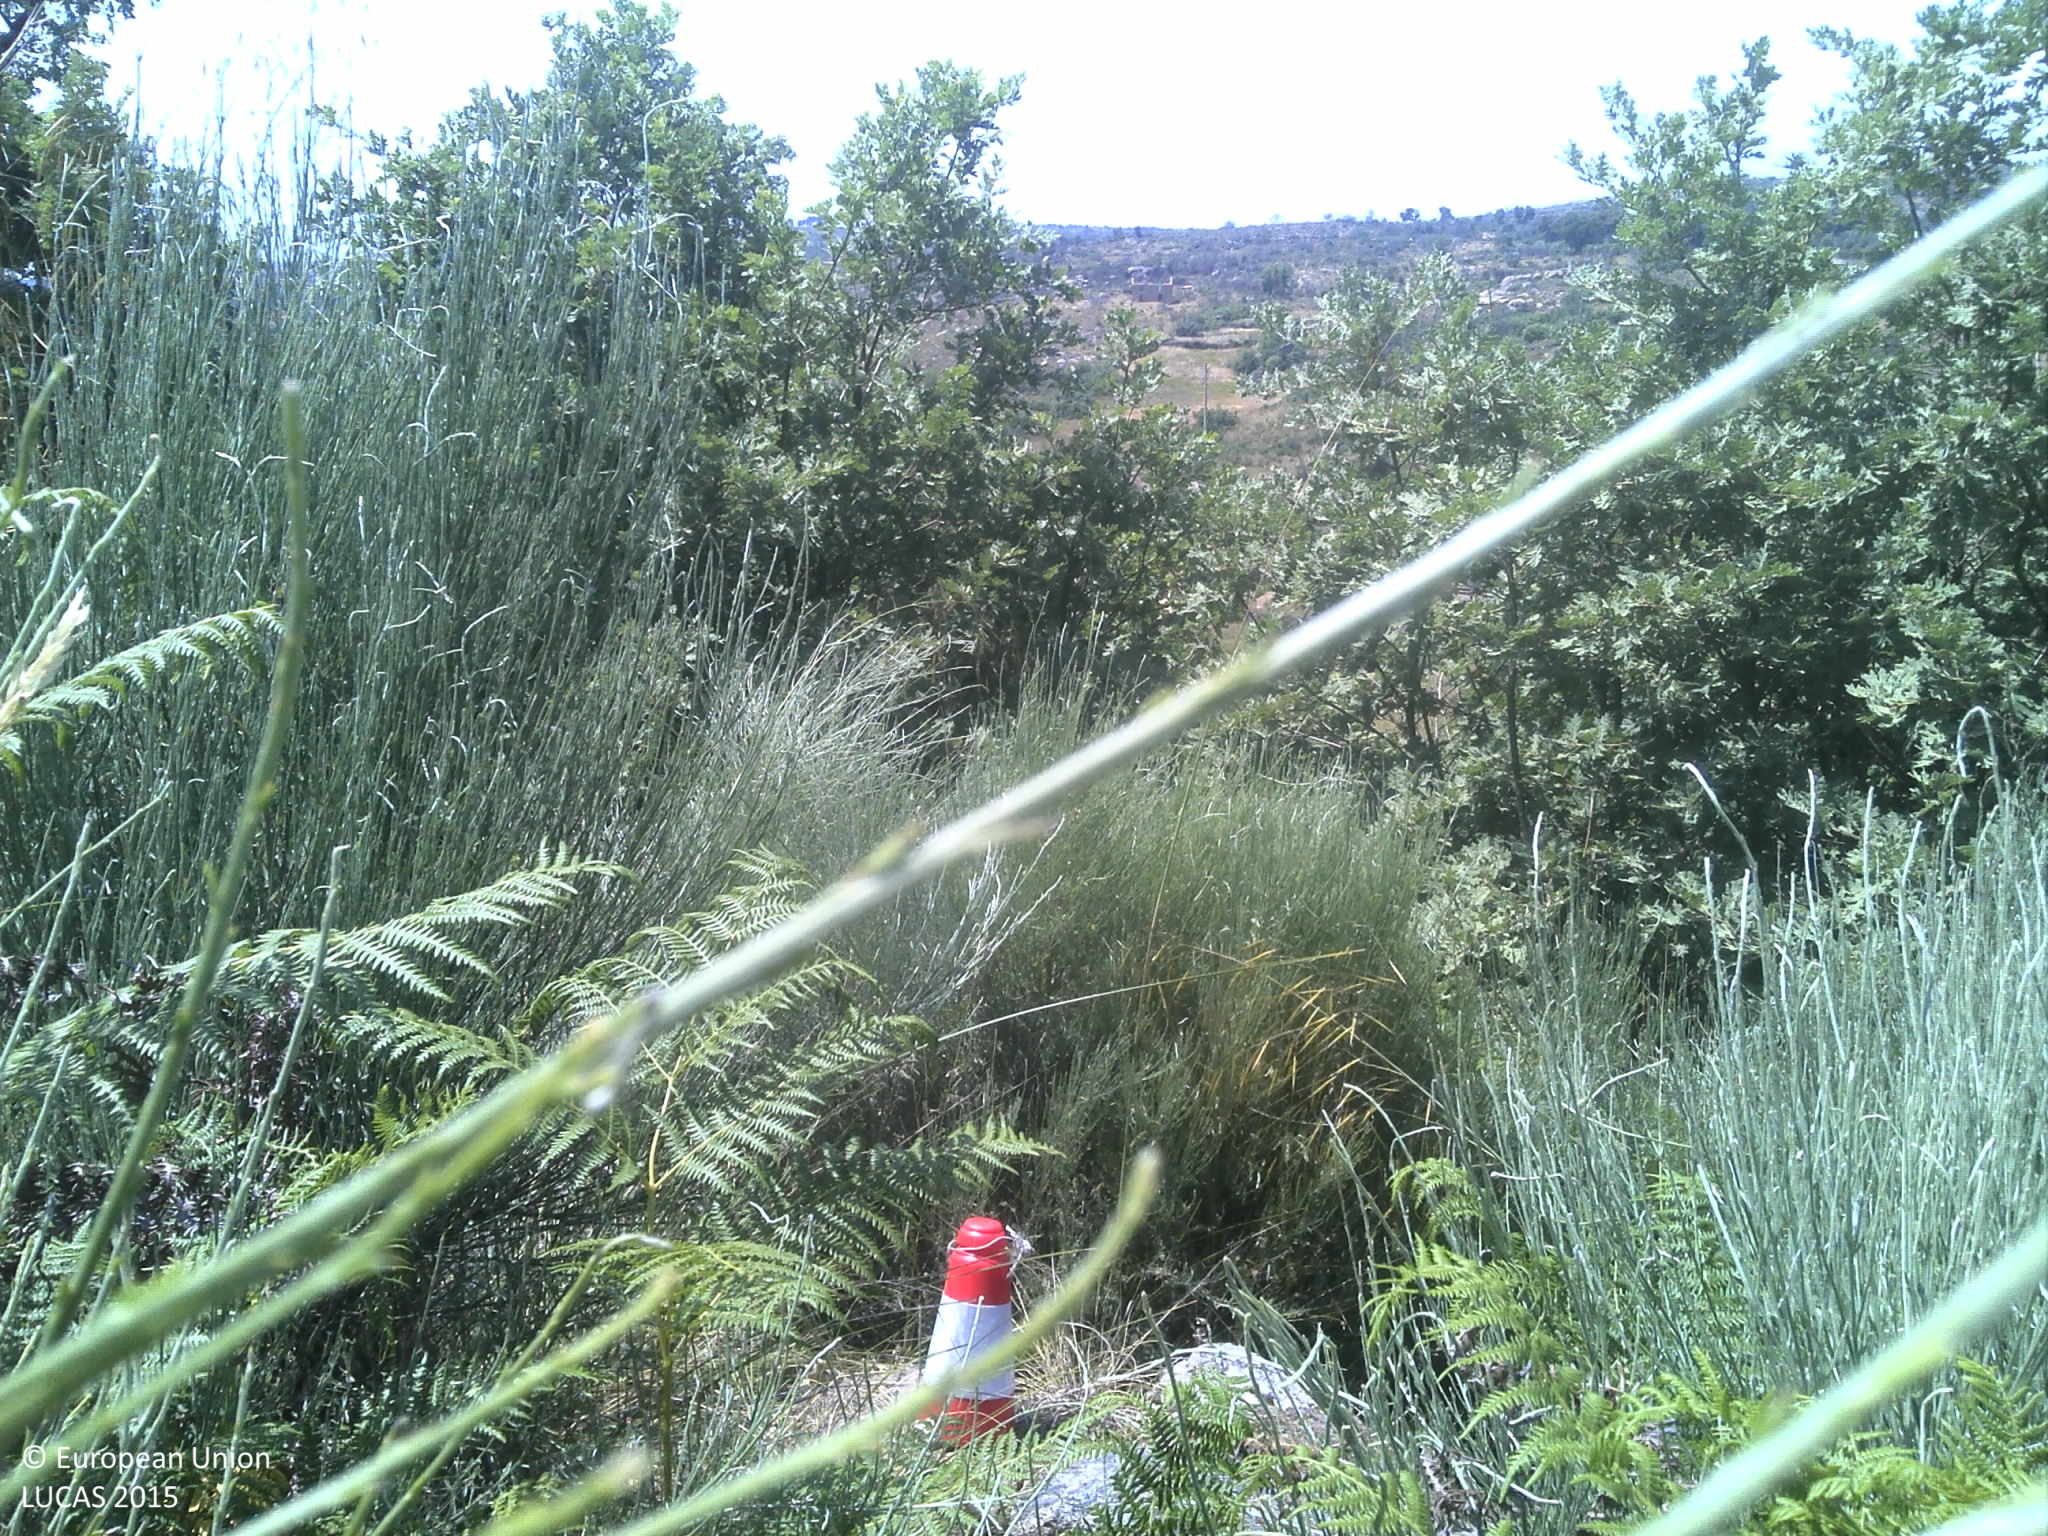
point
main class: Shrubland
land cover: Shrubland with sparse tree cover
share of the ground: 50 - 75 %
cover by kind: shrubs 70 %, herbaceous plants 15 %, unconsolidated bare surface 10 %, broadleaved forest trees 5 %
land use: Semi-natural and natural areas not in use
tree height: < 5 m
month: June
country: PT
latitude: 40.5245
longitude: -6.9906
